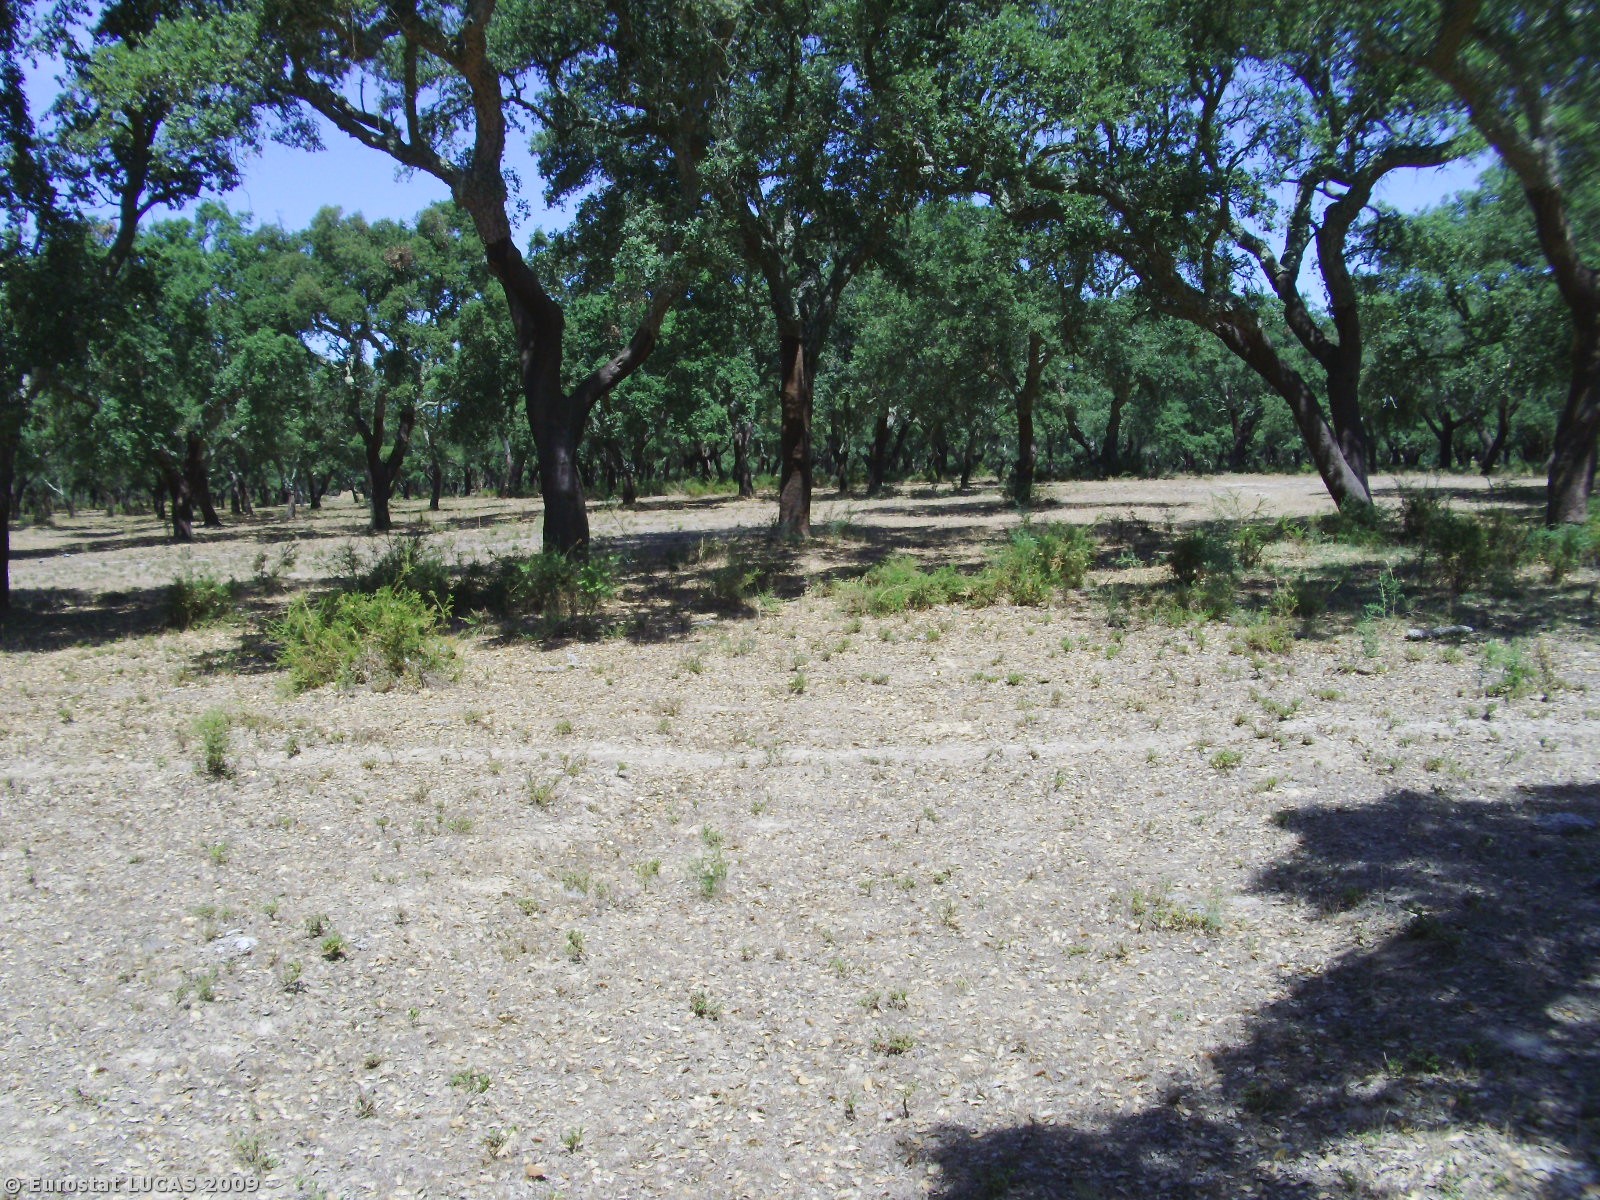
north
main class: Woodland
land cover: Broadleaved woodland
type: broadleaved evergreen forest
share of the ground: 25 - 50 %
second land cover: Spontaneously vegetated surfaces
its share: 50 - 75 %
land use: Forestry
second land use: Fallow land
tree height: > 5 m
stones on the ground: 10 - 25 %
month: August
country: PT
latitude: 38.6960
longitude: -8.8655
